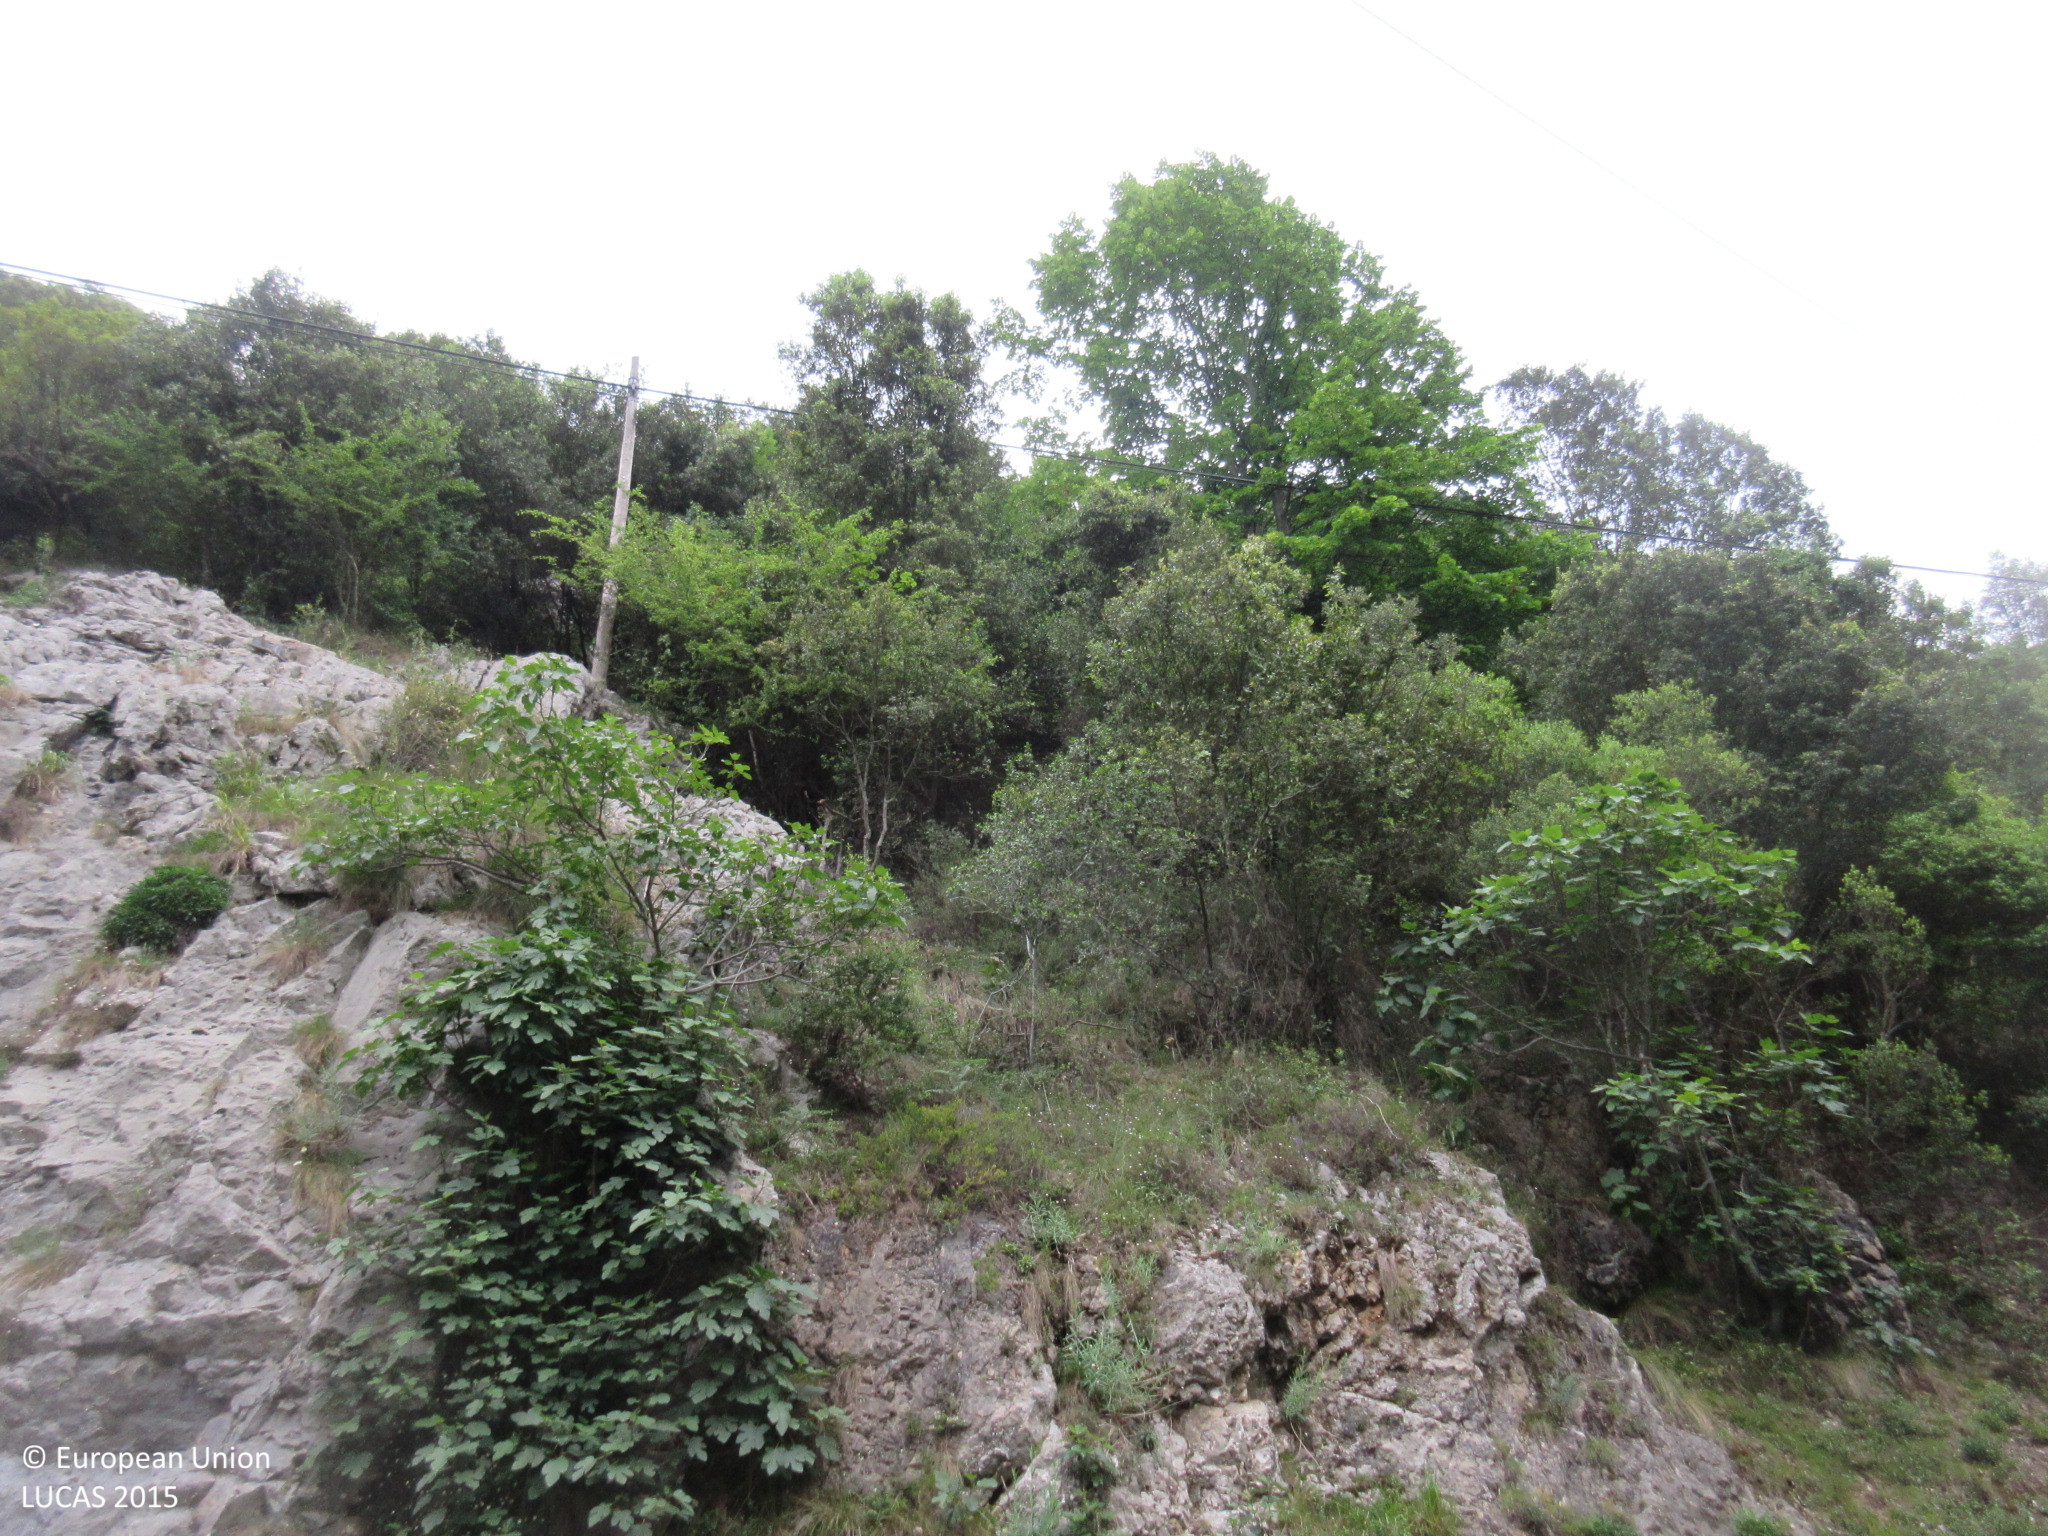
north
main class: Woodland
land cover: Broadleaved woodland
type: floodplain forest
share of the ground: > 75 %
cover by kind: broadleaved forest trees 80 %, shrubs 20 %
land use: Semi-natural and natural areas not in use
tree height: > 5 m
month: May
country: ES
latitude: 43.2906
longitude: -4.6174
